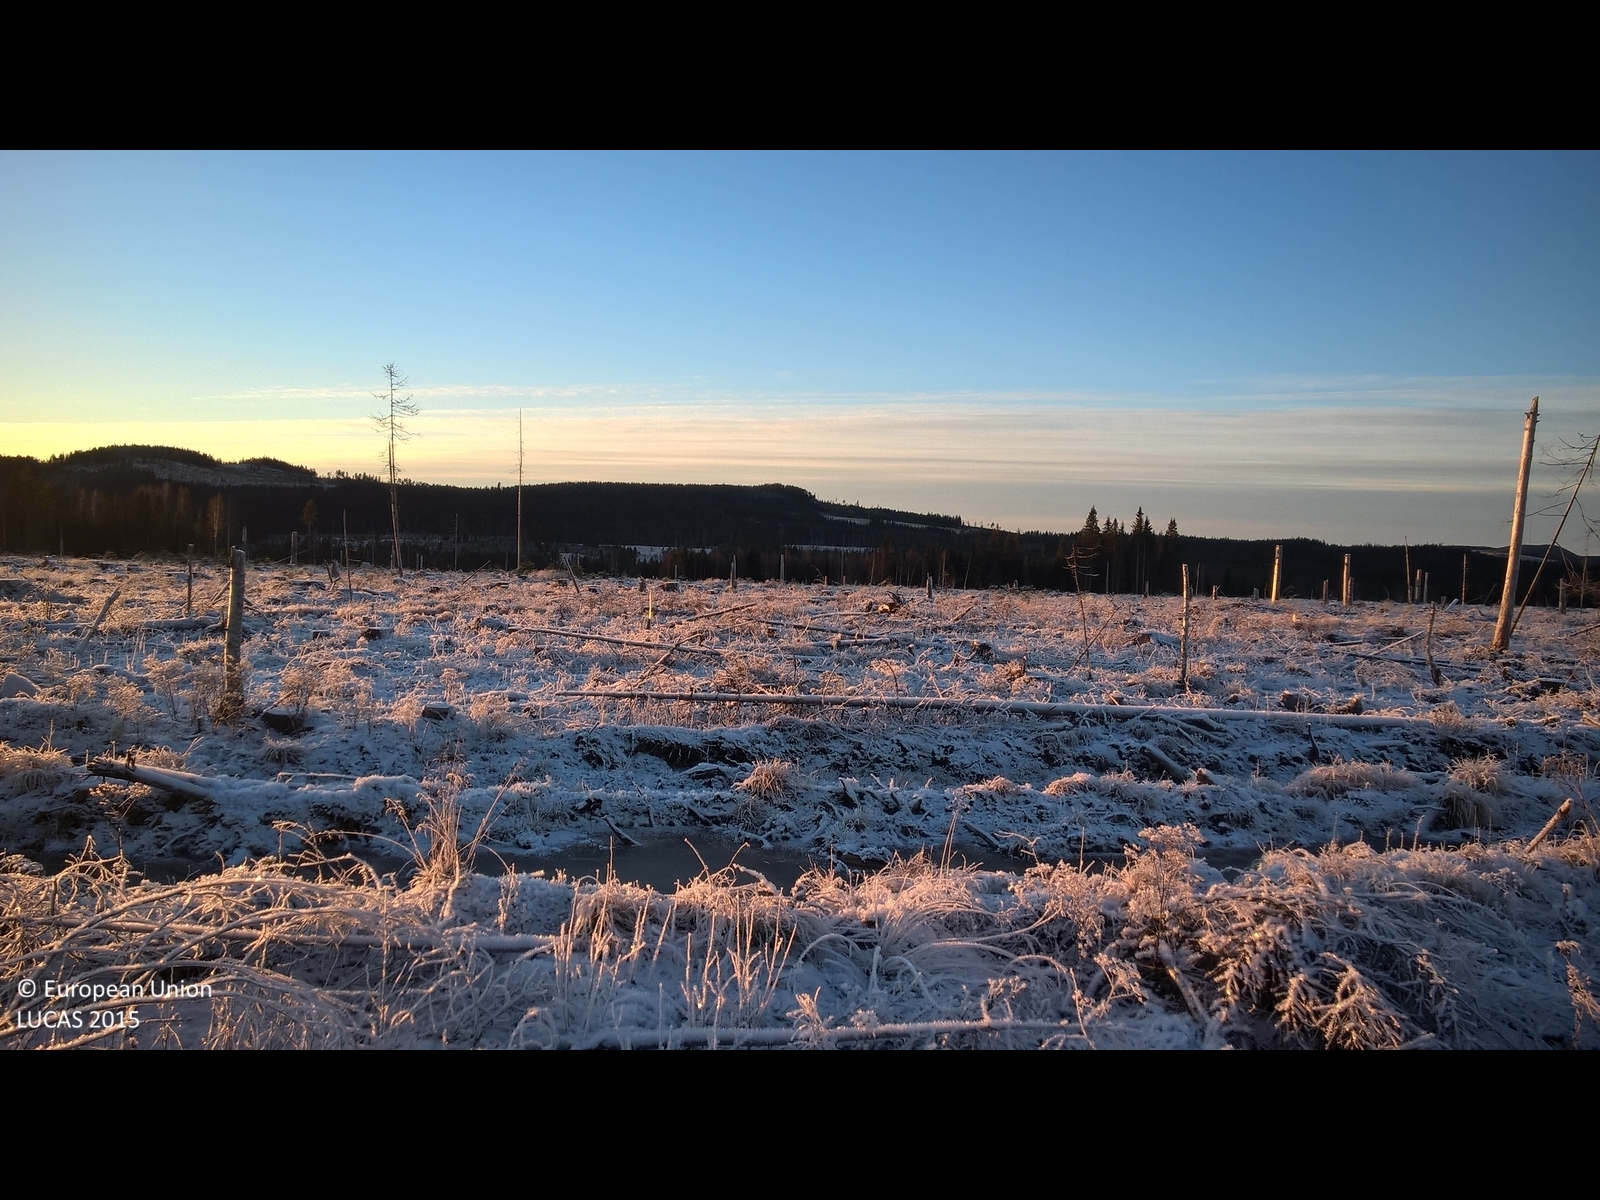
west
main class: Grassland
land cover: Grassland with sparse tree/shrub cover
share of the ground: 10 - 25 %
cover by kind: lichens and mosses 75 %, herbaceous plants 15 %, coniferous forest trees 5 %, shrubs 5 %
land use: Forestry
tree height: > 5 m
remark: Clear cut
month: November
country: SE
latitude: 60.3881
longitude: 14.2162
